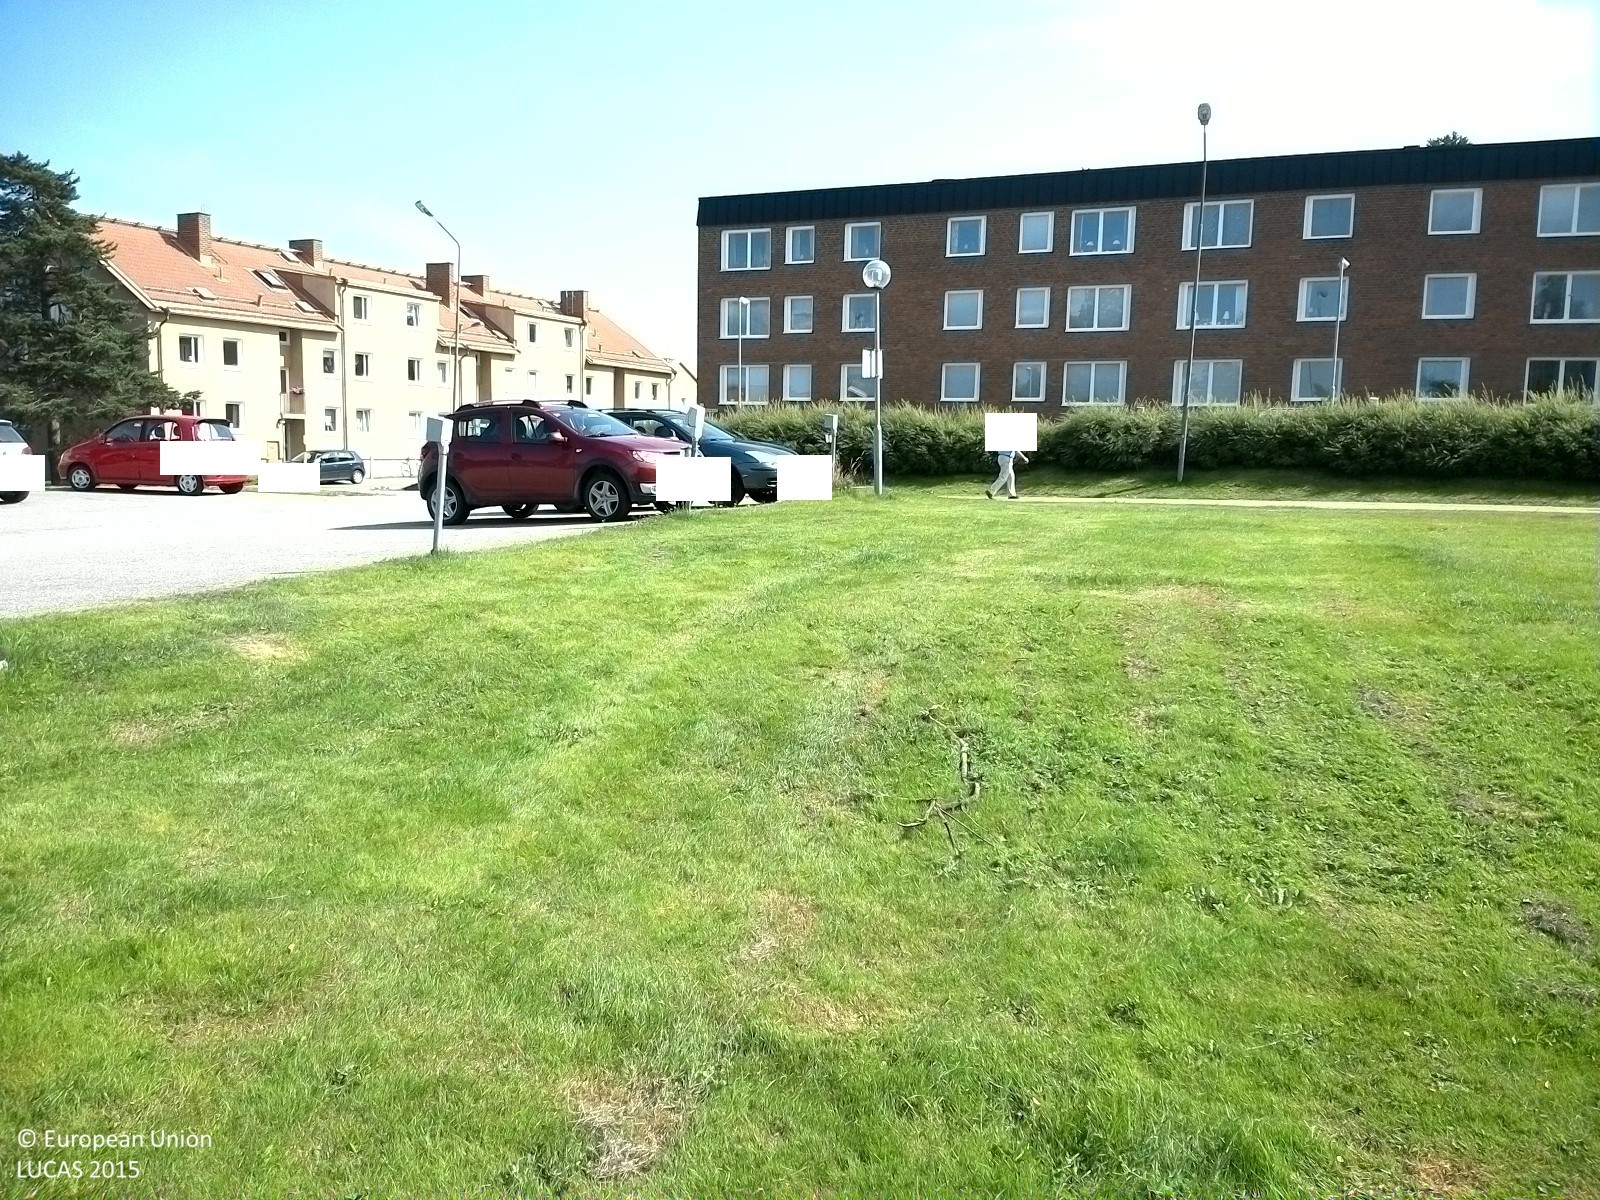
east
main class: Grassland
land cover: Grassland without tree/shrub cover
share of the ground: > 75 %
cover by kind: herbaceous plants 100 %
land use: Amenities, museums, leisure
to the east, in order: Grassland without tree/shrub cover; Artificial constructions in urban areas
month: August
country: SE
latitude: 62.3786
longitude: 17.3469
